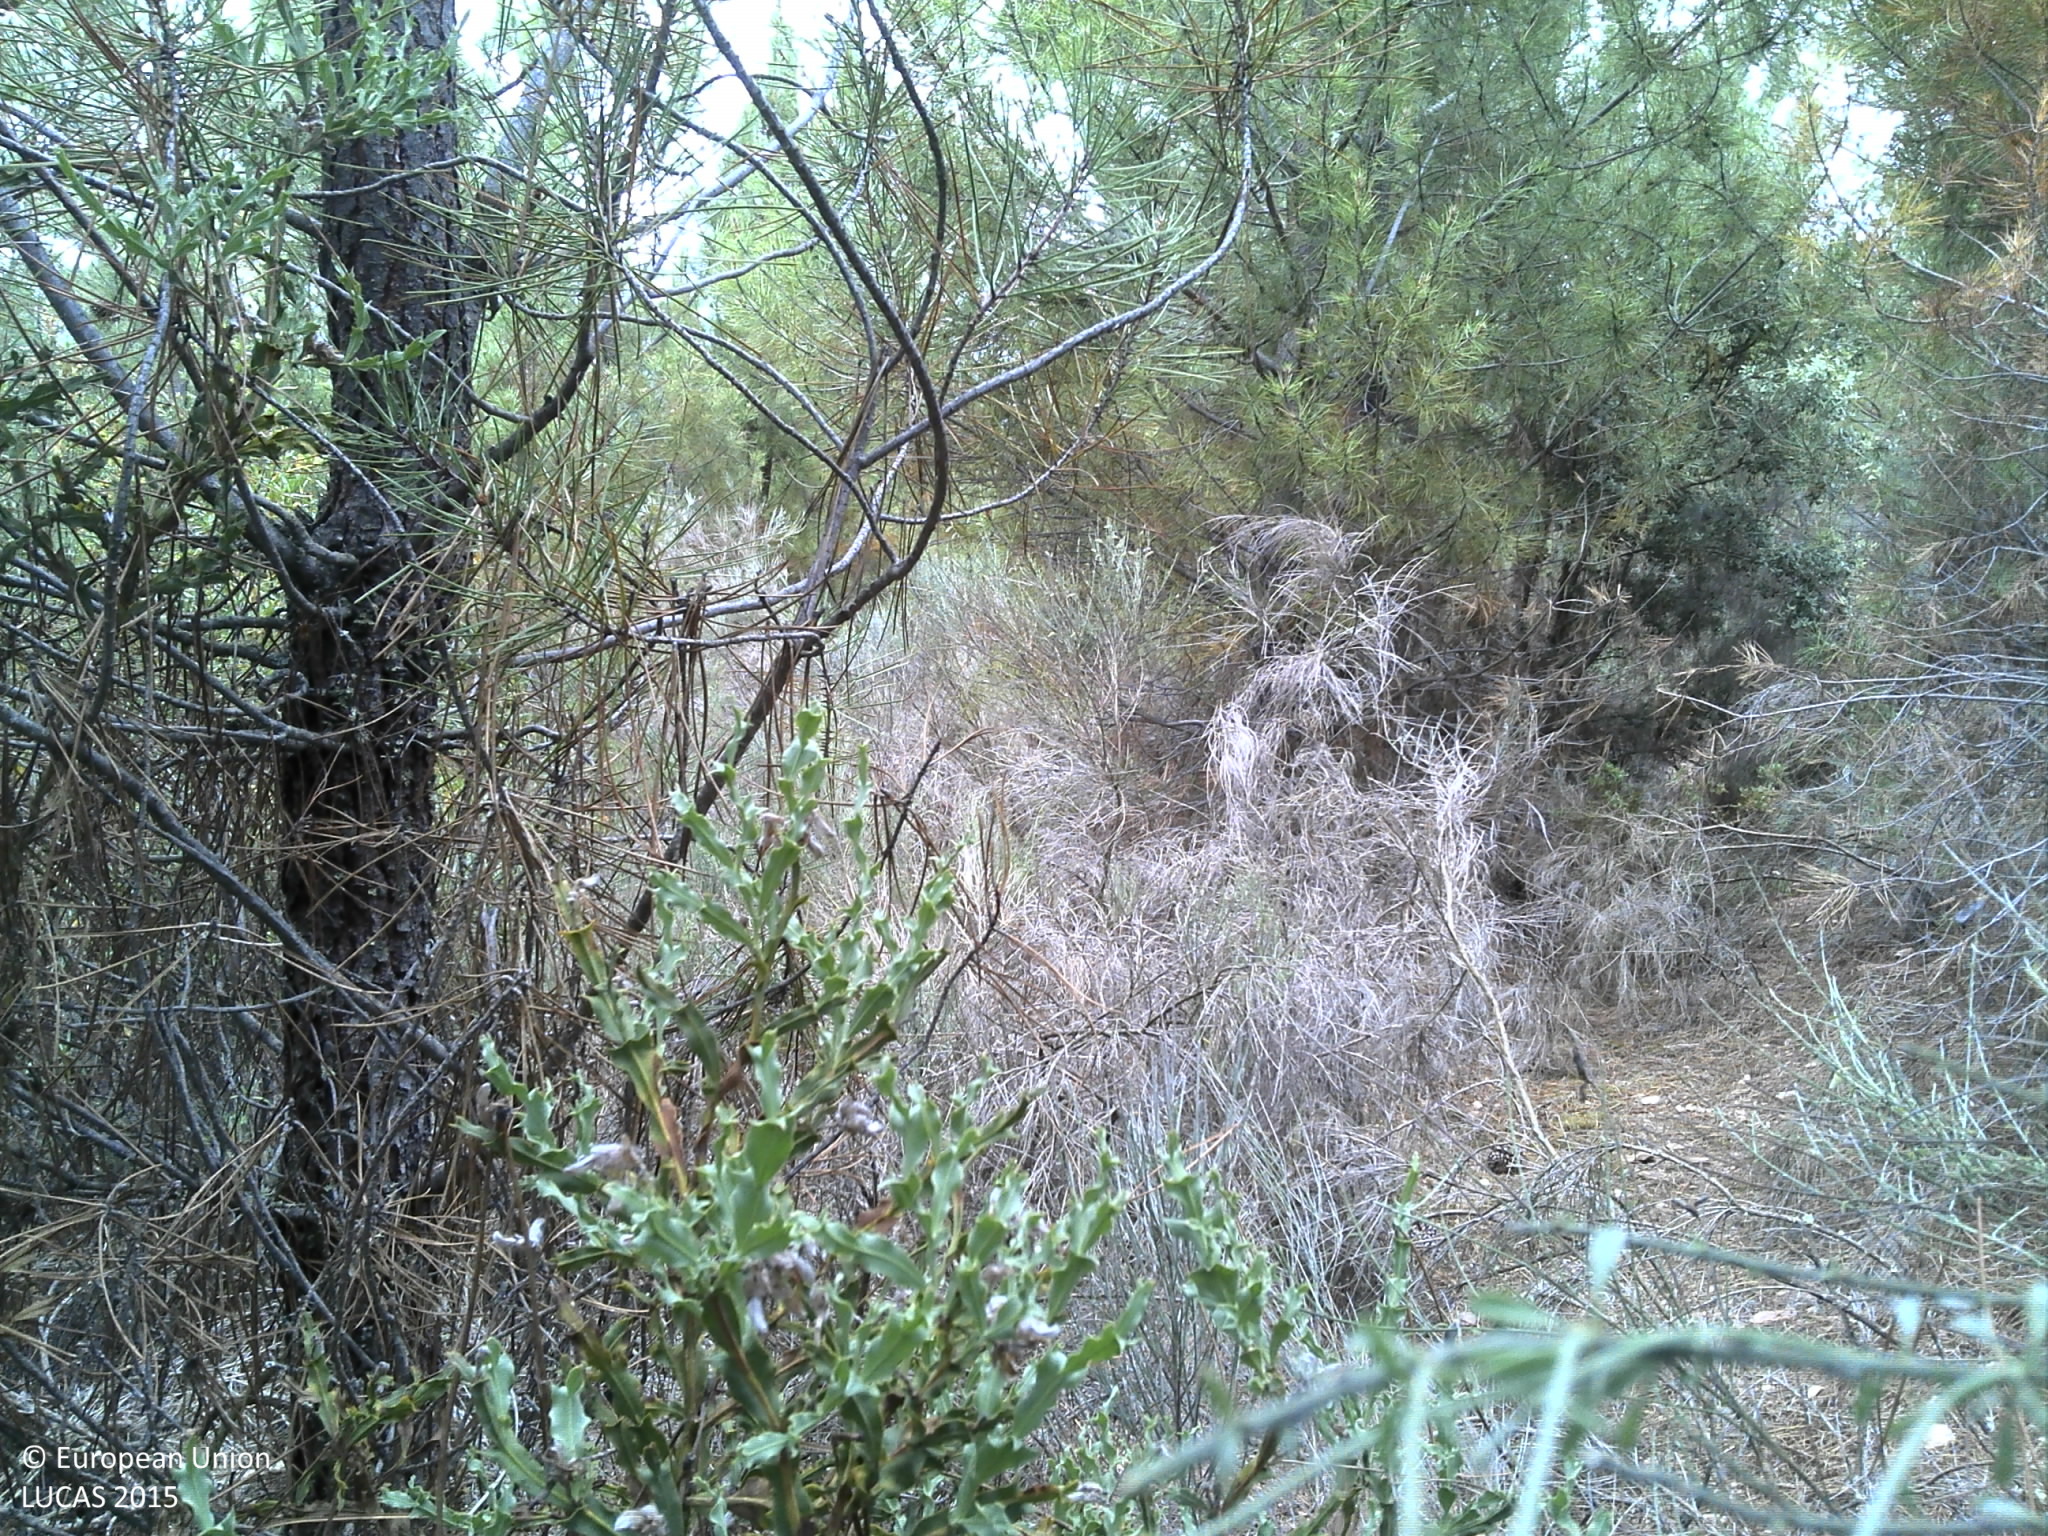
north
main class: Woodland
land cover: Pine dominated coniferous woodland
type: coniferous forest of the mediterranean region
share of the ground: 25 - 50 %
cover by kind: shrubs 55 %, coniferous forest trees 25 %, unconsolidated bare surface 20 %
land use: Forestry
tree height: > 5 m
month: June
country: PT
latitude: 41.2638
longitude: -6.9762
